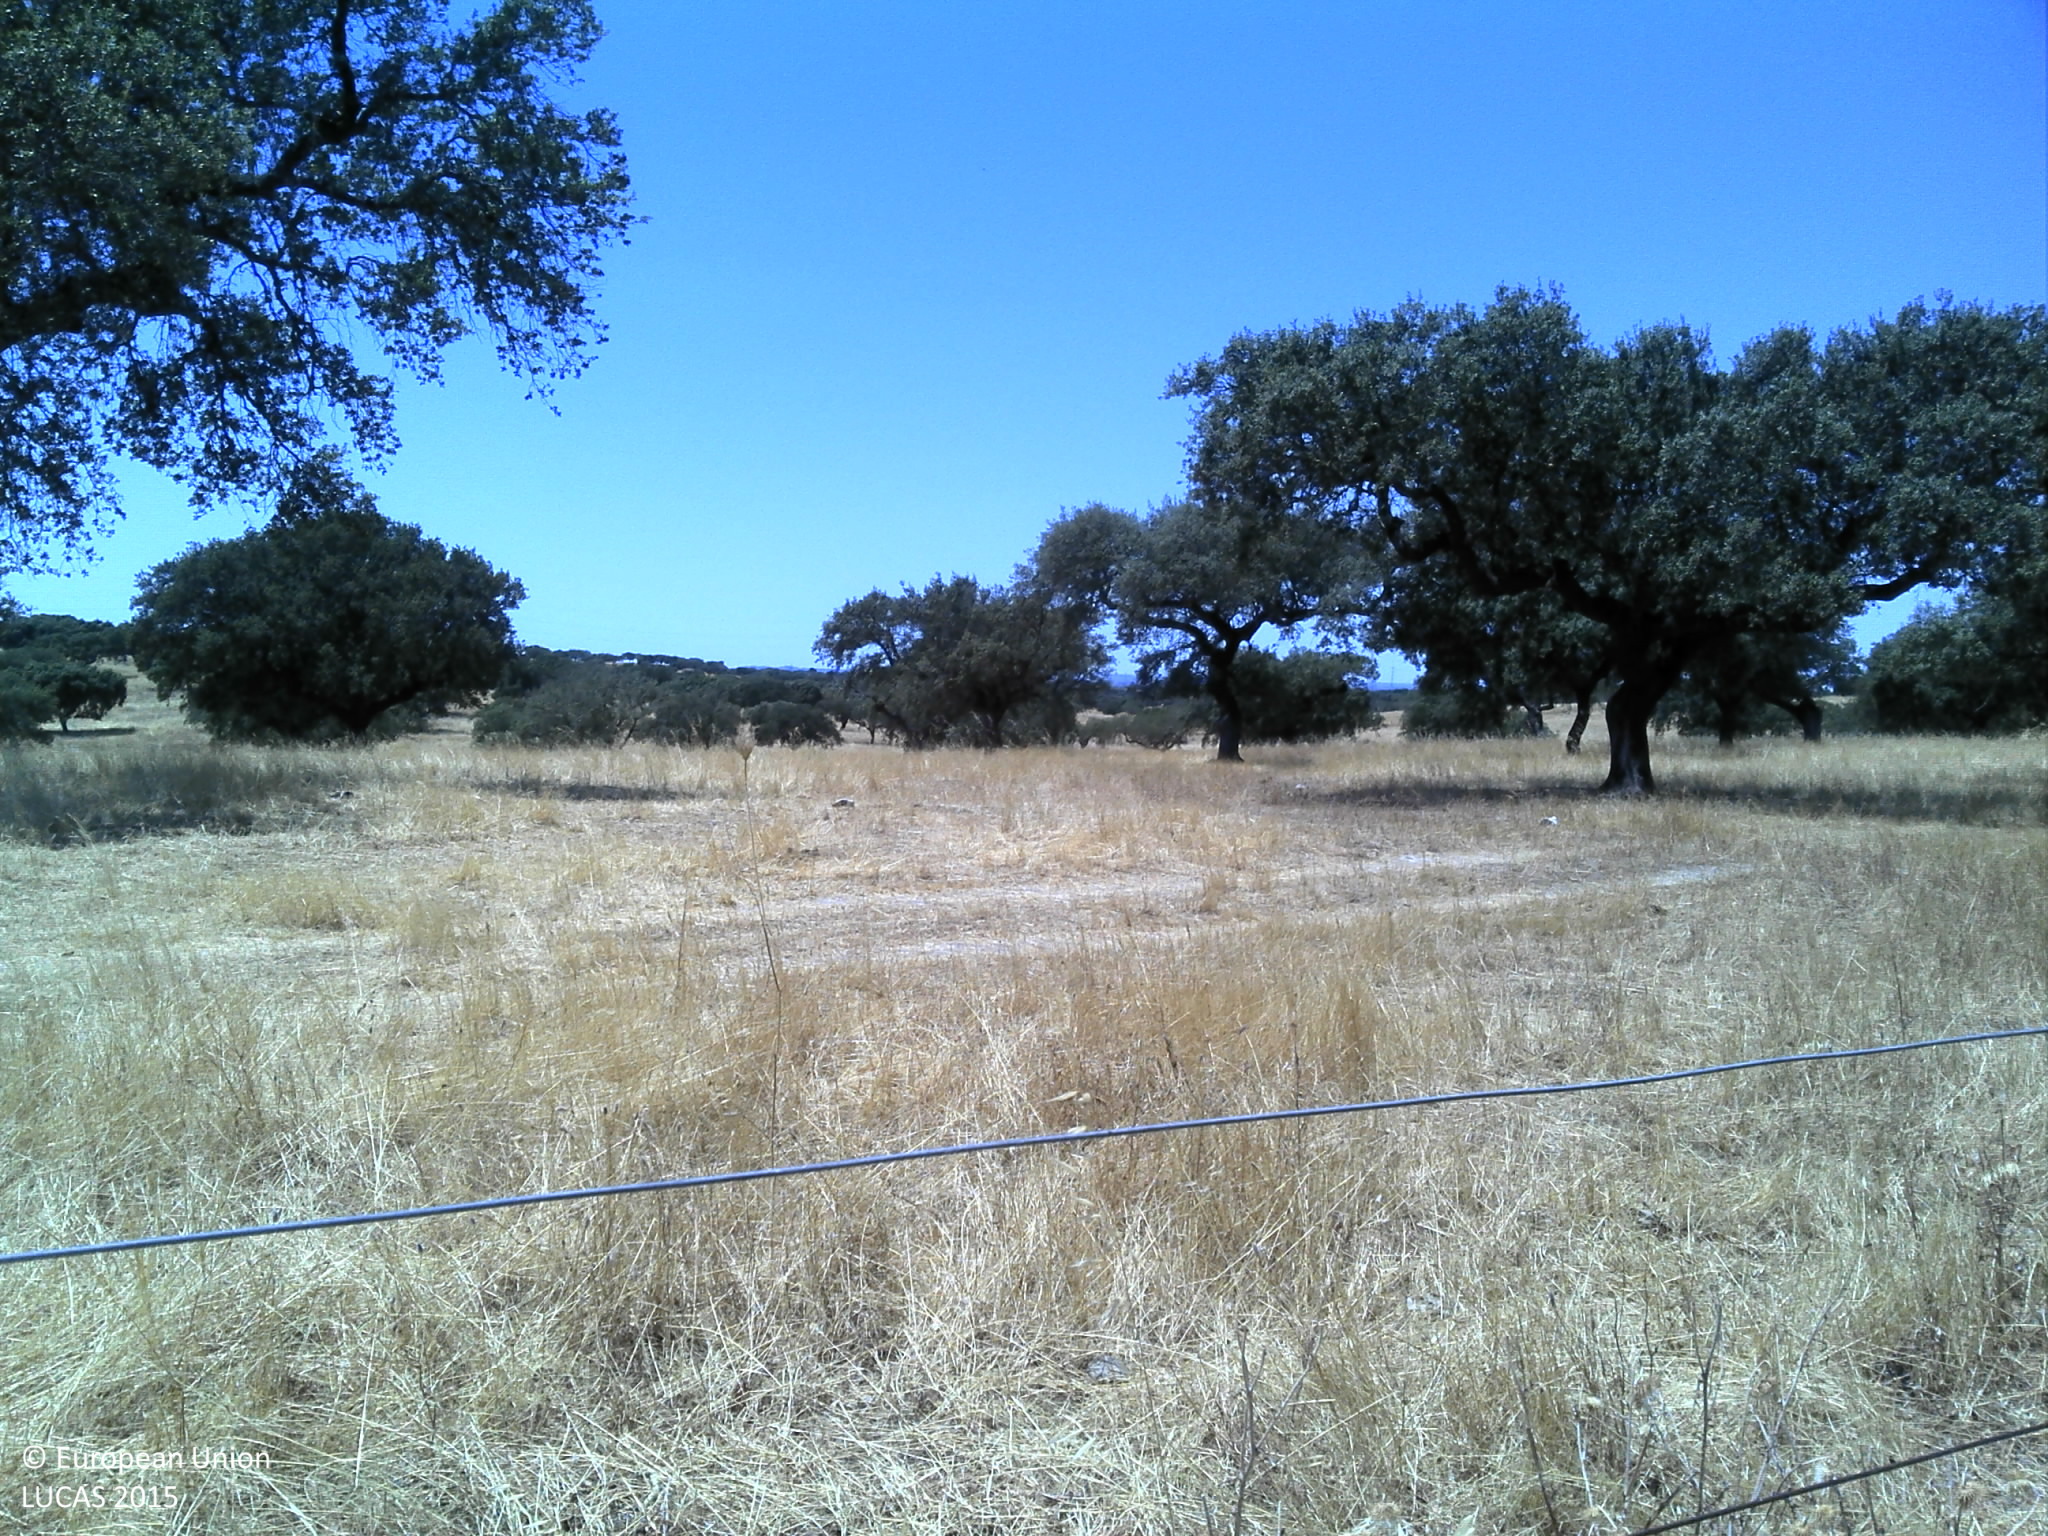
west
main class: Woodland
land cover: Broadleaved woodland
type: broadleaved evergreen forest
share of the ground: 10 - 25 %
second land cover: Grassland without tree/shrub cover
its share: 50 - 75 %
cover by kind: herbaceous plants 60 %, broadleaved forest trees 25 %, unconsolidated bare surface 15 %
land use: Forestry
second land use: Agriculture (excluding fallow land and kitchen gardens)
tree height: > 5 m
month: July
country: PT
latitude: 38.2390
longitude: -7.1889
